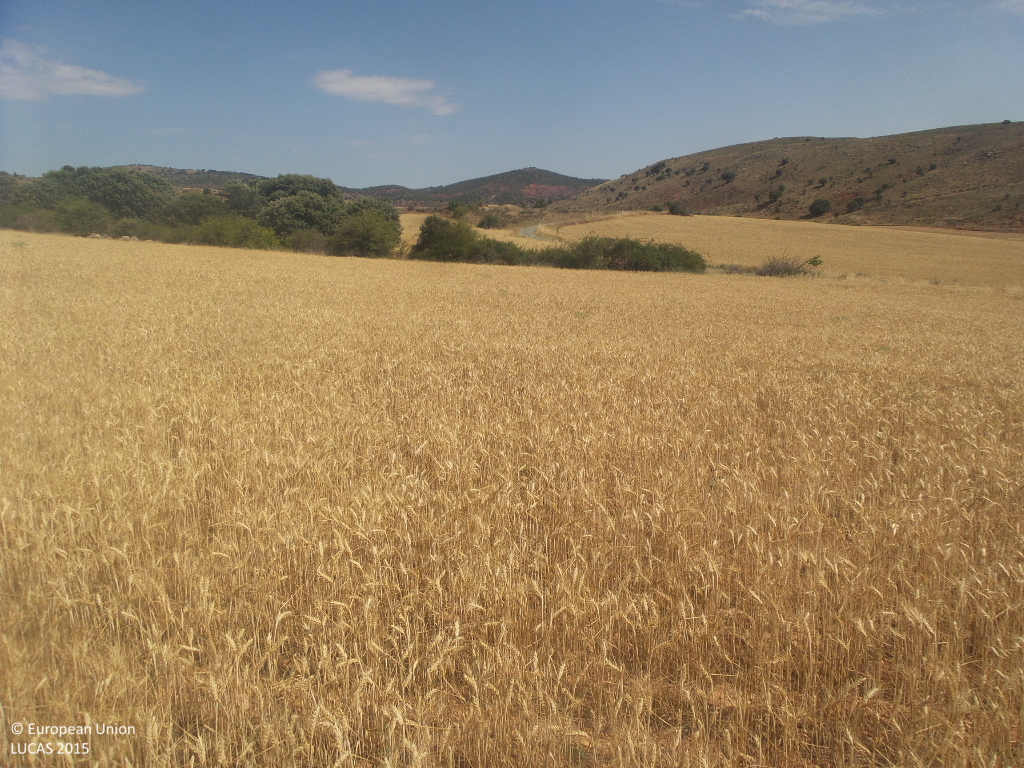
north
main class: Cropland
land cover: Common wheat
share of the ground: > 75 %
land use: Agriculture (excluding fallow land and kitchen gardens)
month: July
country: ES
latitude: 41.1715
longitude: -2.7287
